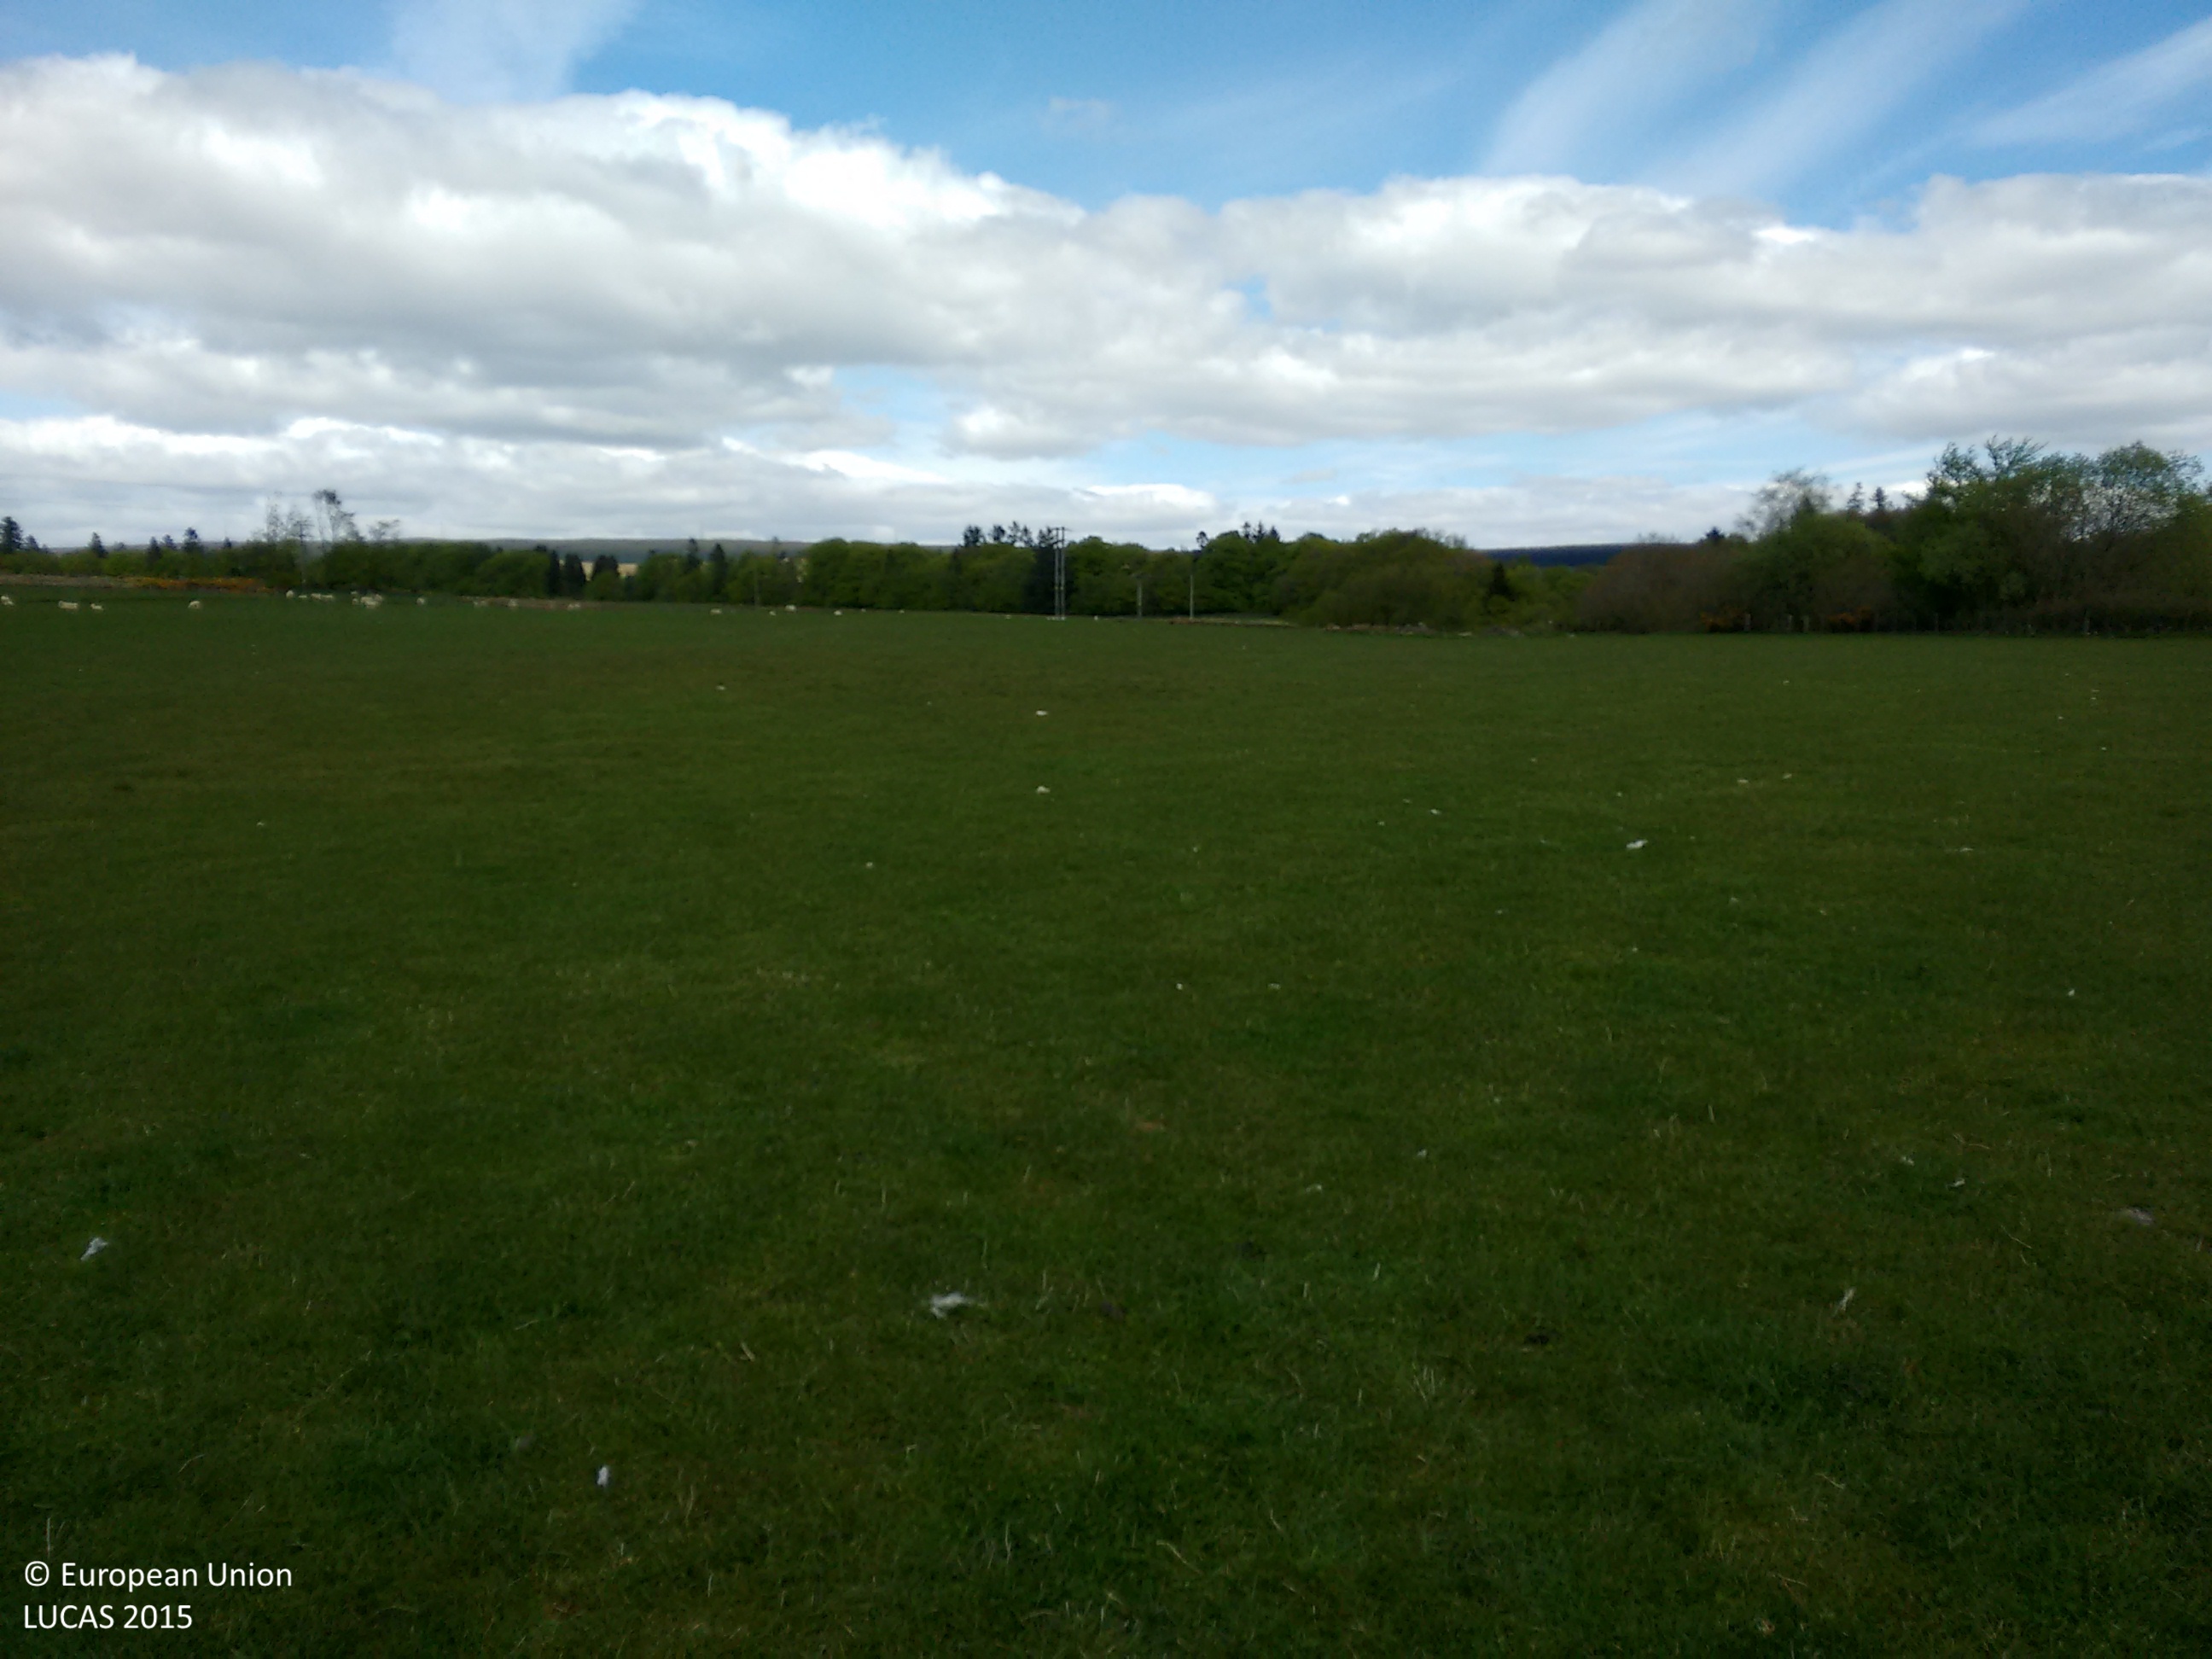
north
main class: Grassland
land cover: Grassland without tree/shrub cover
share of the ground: > 75 %
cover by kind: herbaceous plants 100 %
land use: Agriculture (excluding fallow land and kitchen gardens)
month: May
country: GB
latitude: 56.2681
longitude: -3.8894
